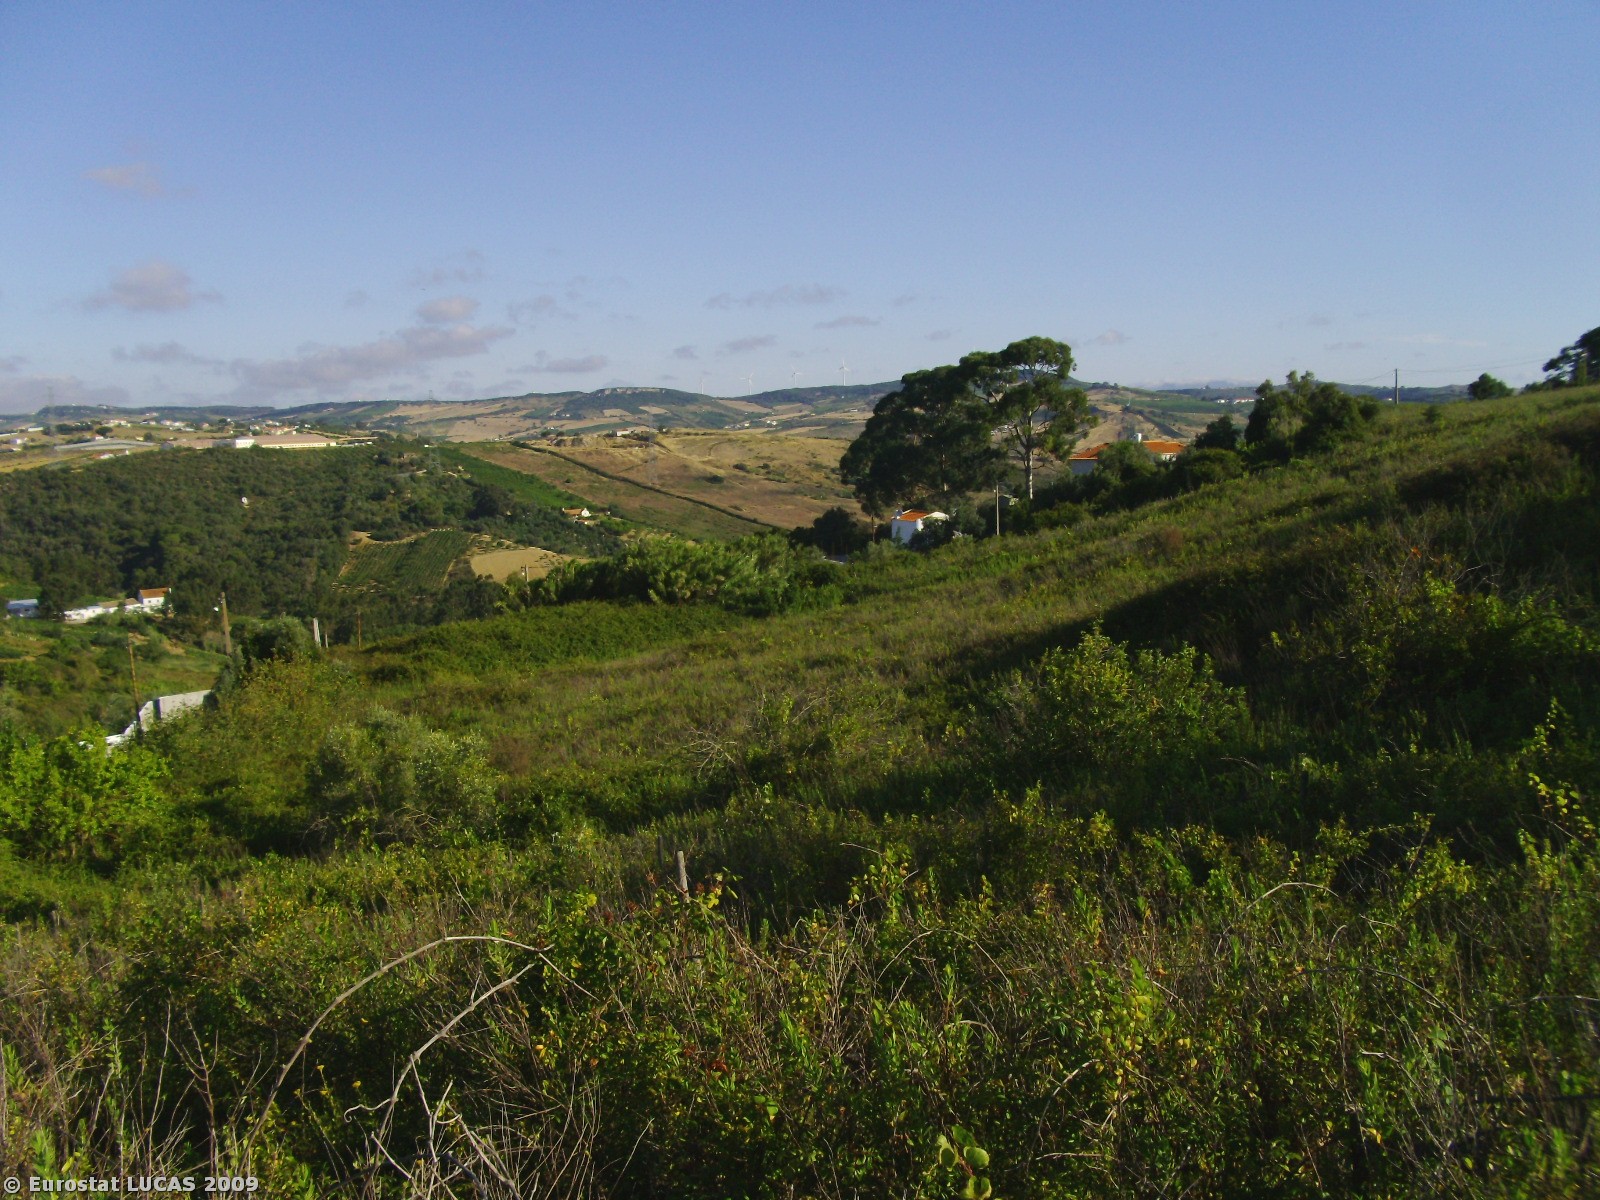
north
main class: Cropland
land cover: Vineyards
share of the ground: 25 - 50 %
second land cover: Shrubland without tree cover
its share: 50 - 75 %
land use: Fallow land
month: July
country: PT
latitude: 38.9802
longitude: -9.0198
